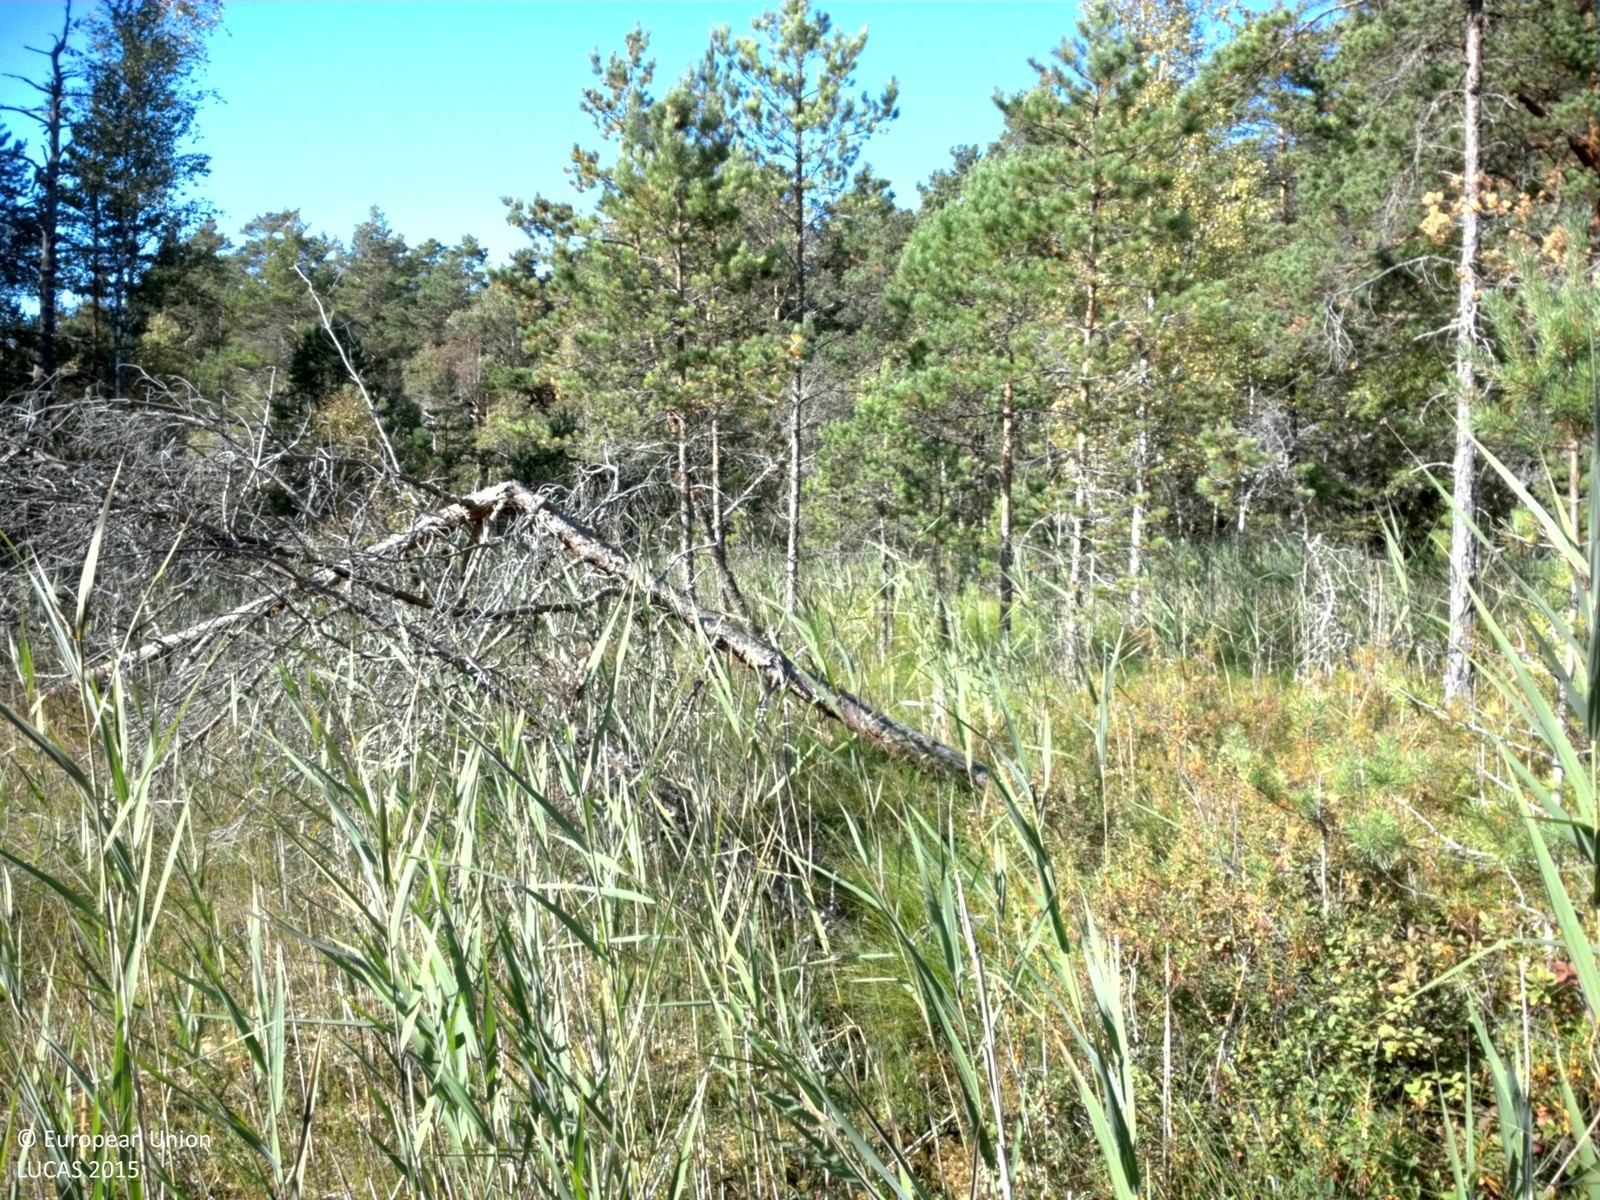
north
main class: Woodland
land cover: Pine dominated coniferous woodland
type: boreal forest
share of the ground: 25 - 50 %
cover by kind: lichens and mosses 55 %, coniferous forest trees 30 %, herbaceous plants 10 %, shrubs 5 %
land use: Forestry
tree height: < 5 m
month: August
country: SE
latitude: 59.7867
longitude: 17.7449
